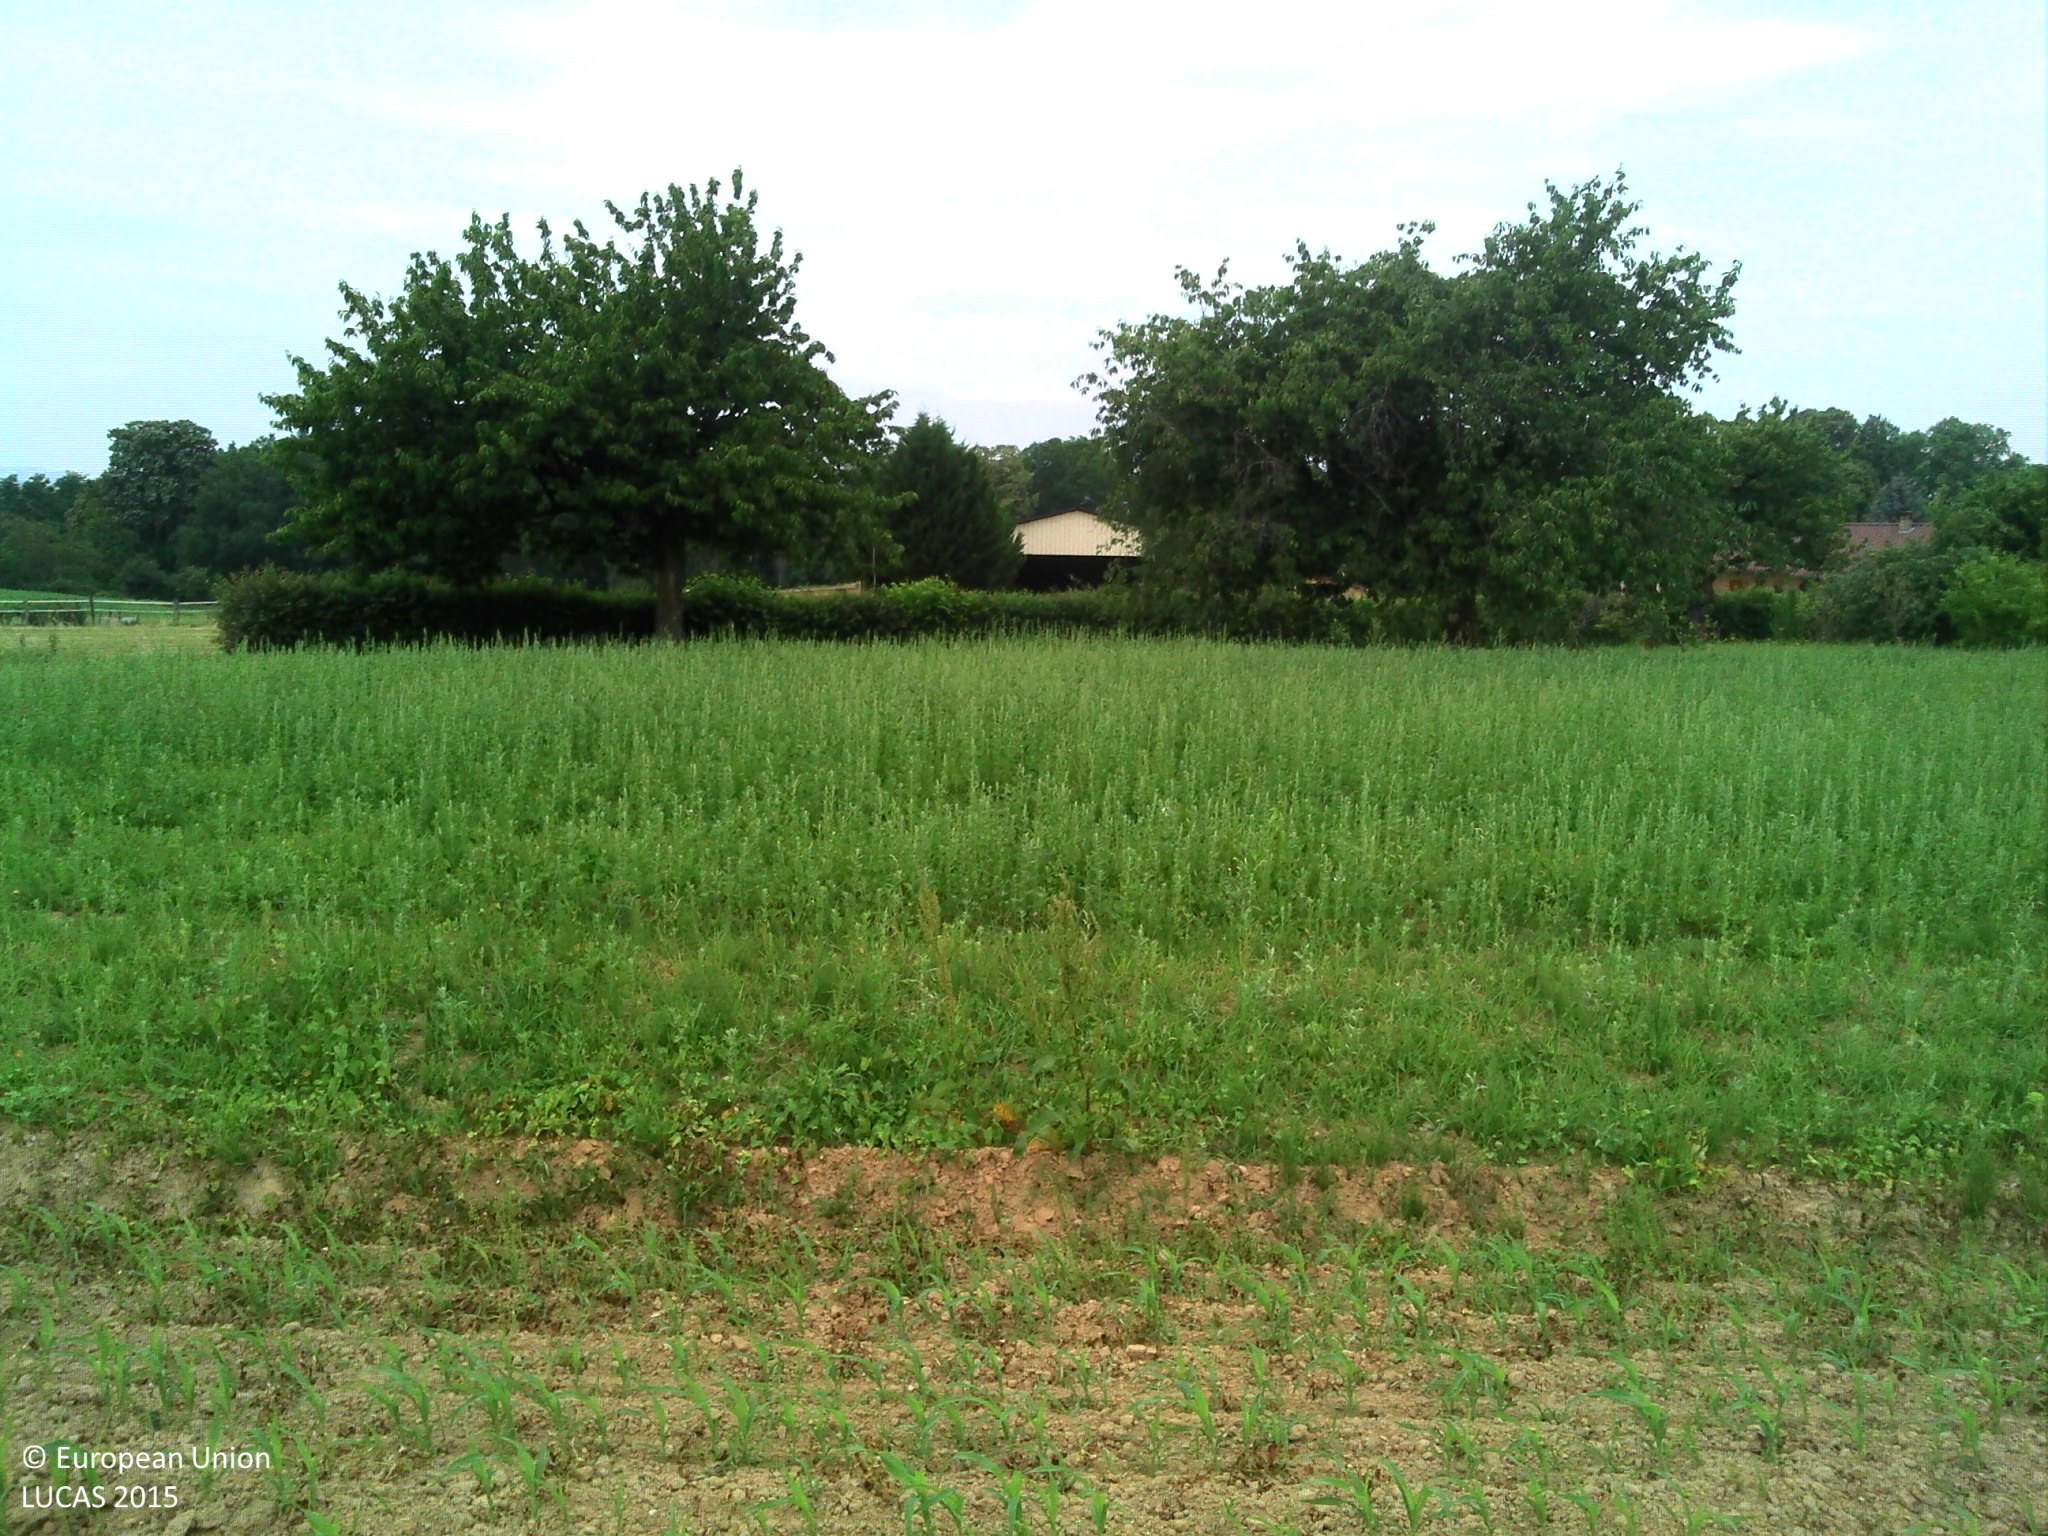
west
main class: Cropland
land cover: Maize
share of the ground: 25 - 50 %
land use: Agriculture (excluding fallow land and kitchen gardens)
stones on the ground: < 10 %
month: June
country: FR
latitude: 46.1351
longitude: 4.8121
